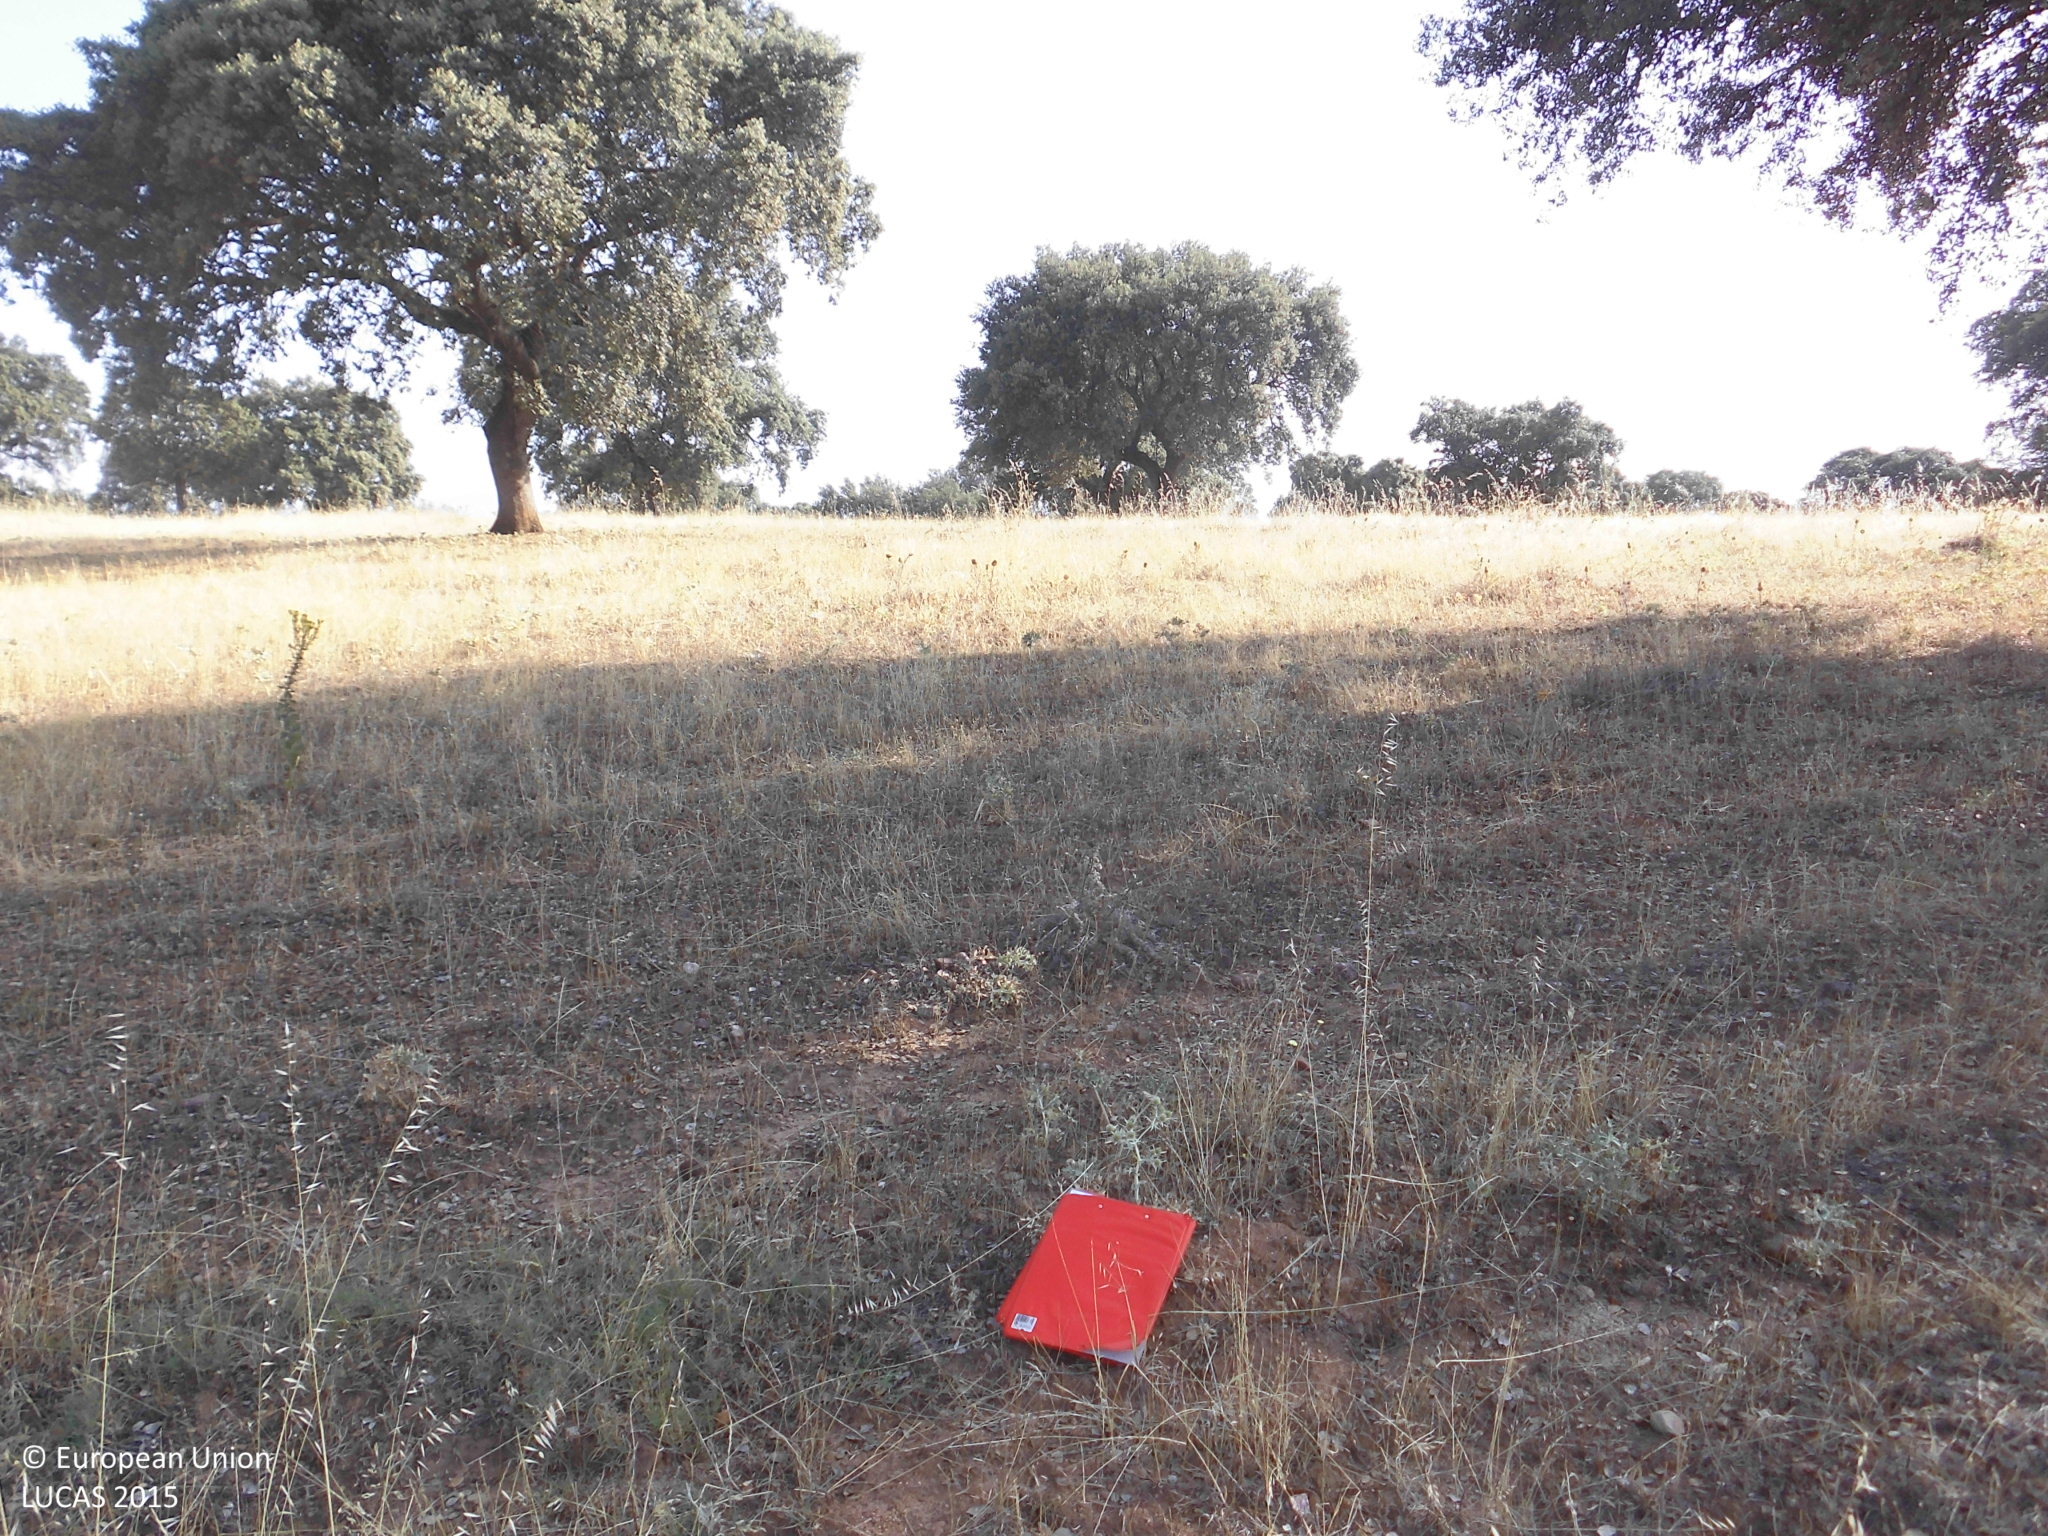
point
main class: Woodland
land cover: Broadleaved woodland
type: broadleaved evergreen forest
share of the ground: 25 - 50 %
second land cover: Grassland without tree/shrub cover
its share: > 75 %
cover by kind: herbaceous plants 70 %, broadleaved forest trees 30 %
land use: Forestry
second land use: Agriculture (excluding fallow land and kitchen gardens)
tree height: > 5 m
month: July
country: ES
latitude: 39.8583
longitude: -5.4752
